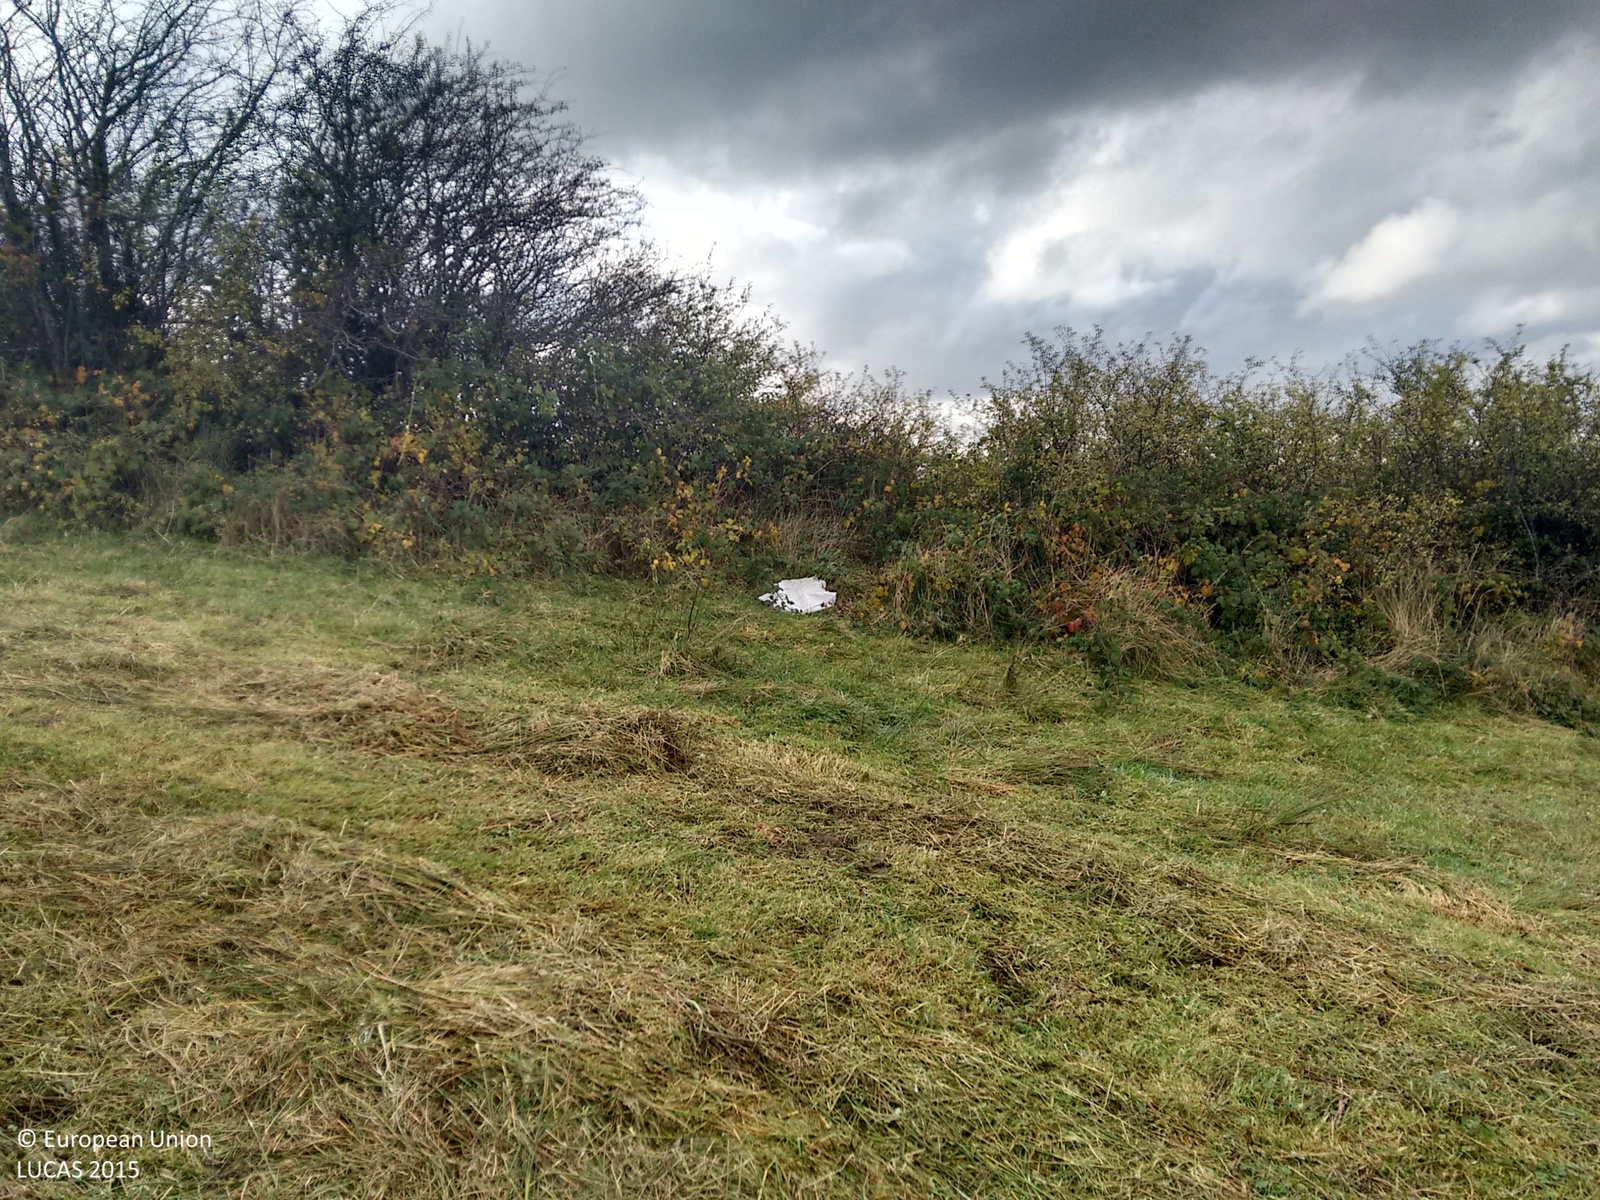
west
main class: Grassland
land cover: Grassland without tree/shrub cover
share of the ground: > 75 %
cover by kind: herbaceous plants 100 %
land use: Agriculture (excluding fallow land and kitchen gardens)
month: October
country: IE
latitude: 53.9917
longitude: -8.1312
